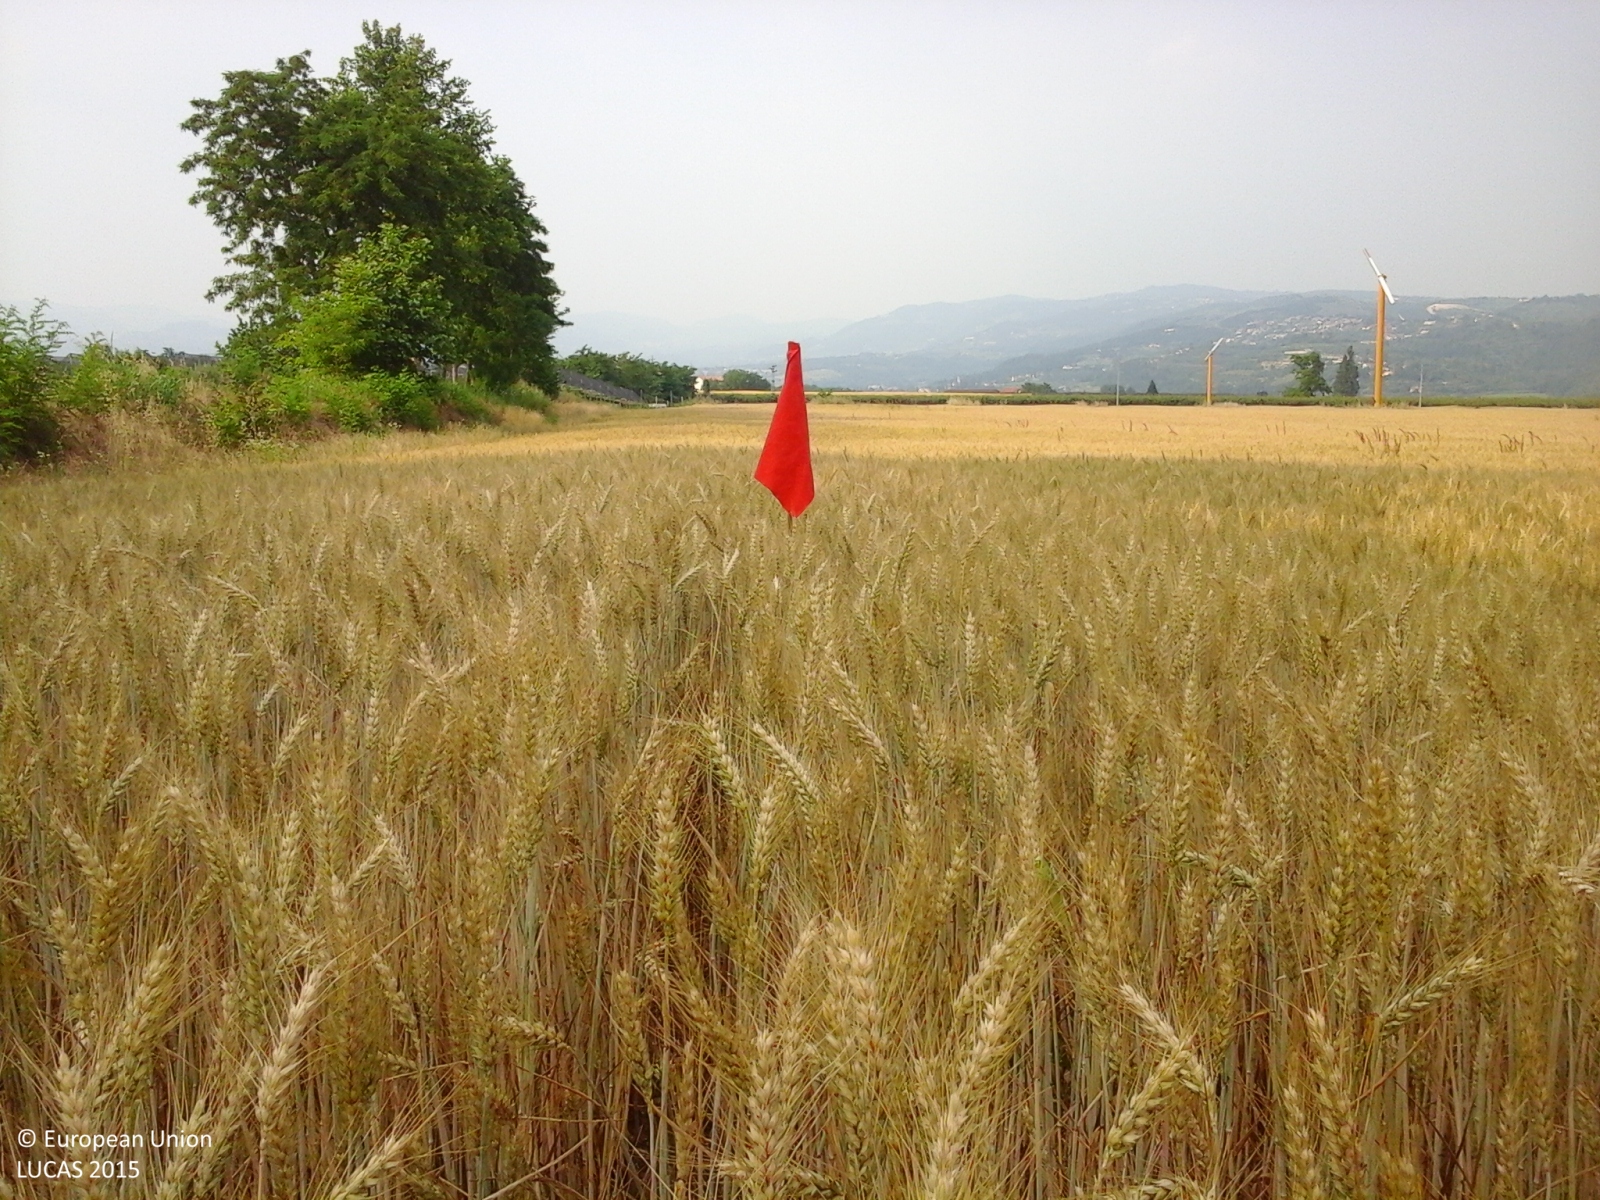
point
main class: Cropland
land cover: Common wheat
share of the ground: > 75 %
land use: Agriculture (excluding fallow land and kitchen gardens)
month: June
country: IT
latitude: 45.4642
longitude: 10.9320
